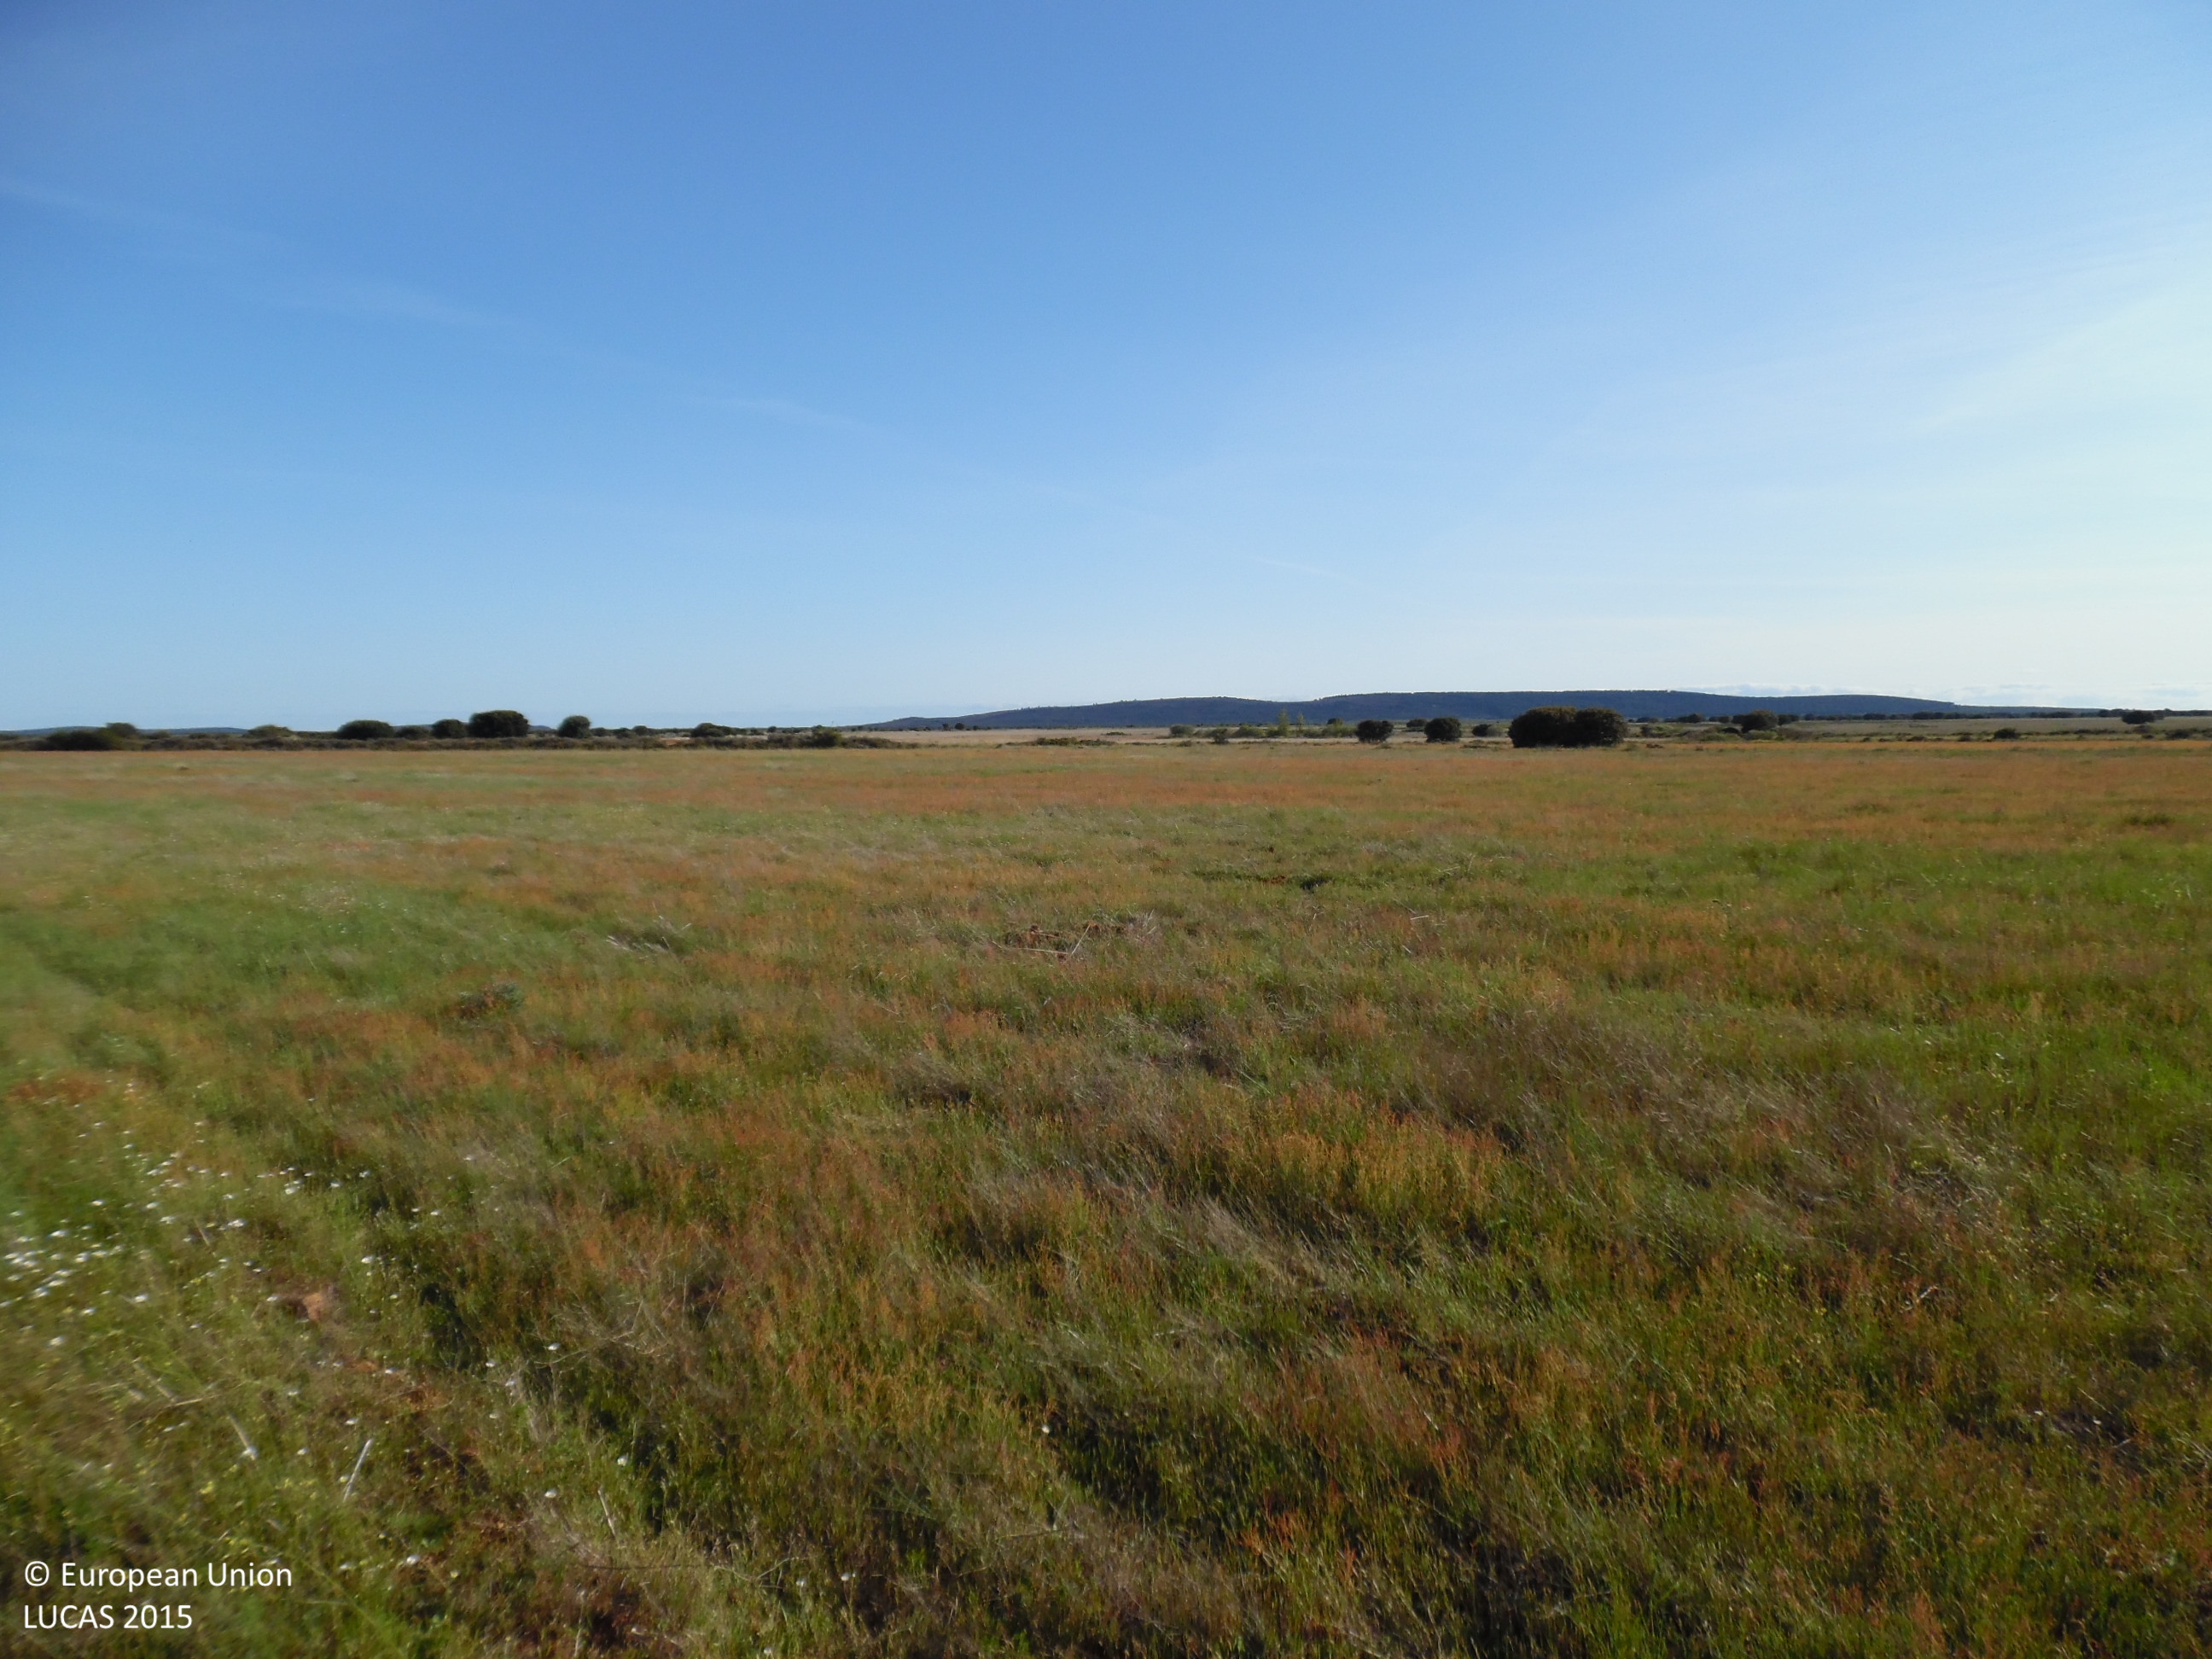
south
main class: Grassland
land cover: Spontaneously vegetated surfaces
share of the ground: > 75 %
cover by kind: herbaceous plants 100 %
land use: Fallow land
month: May
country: ES
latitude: 42.2165
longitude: -6.0072
